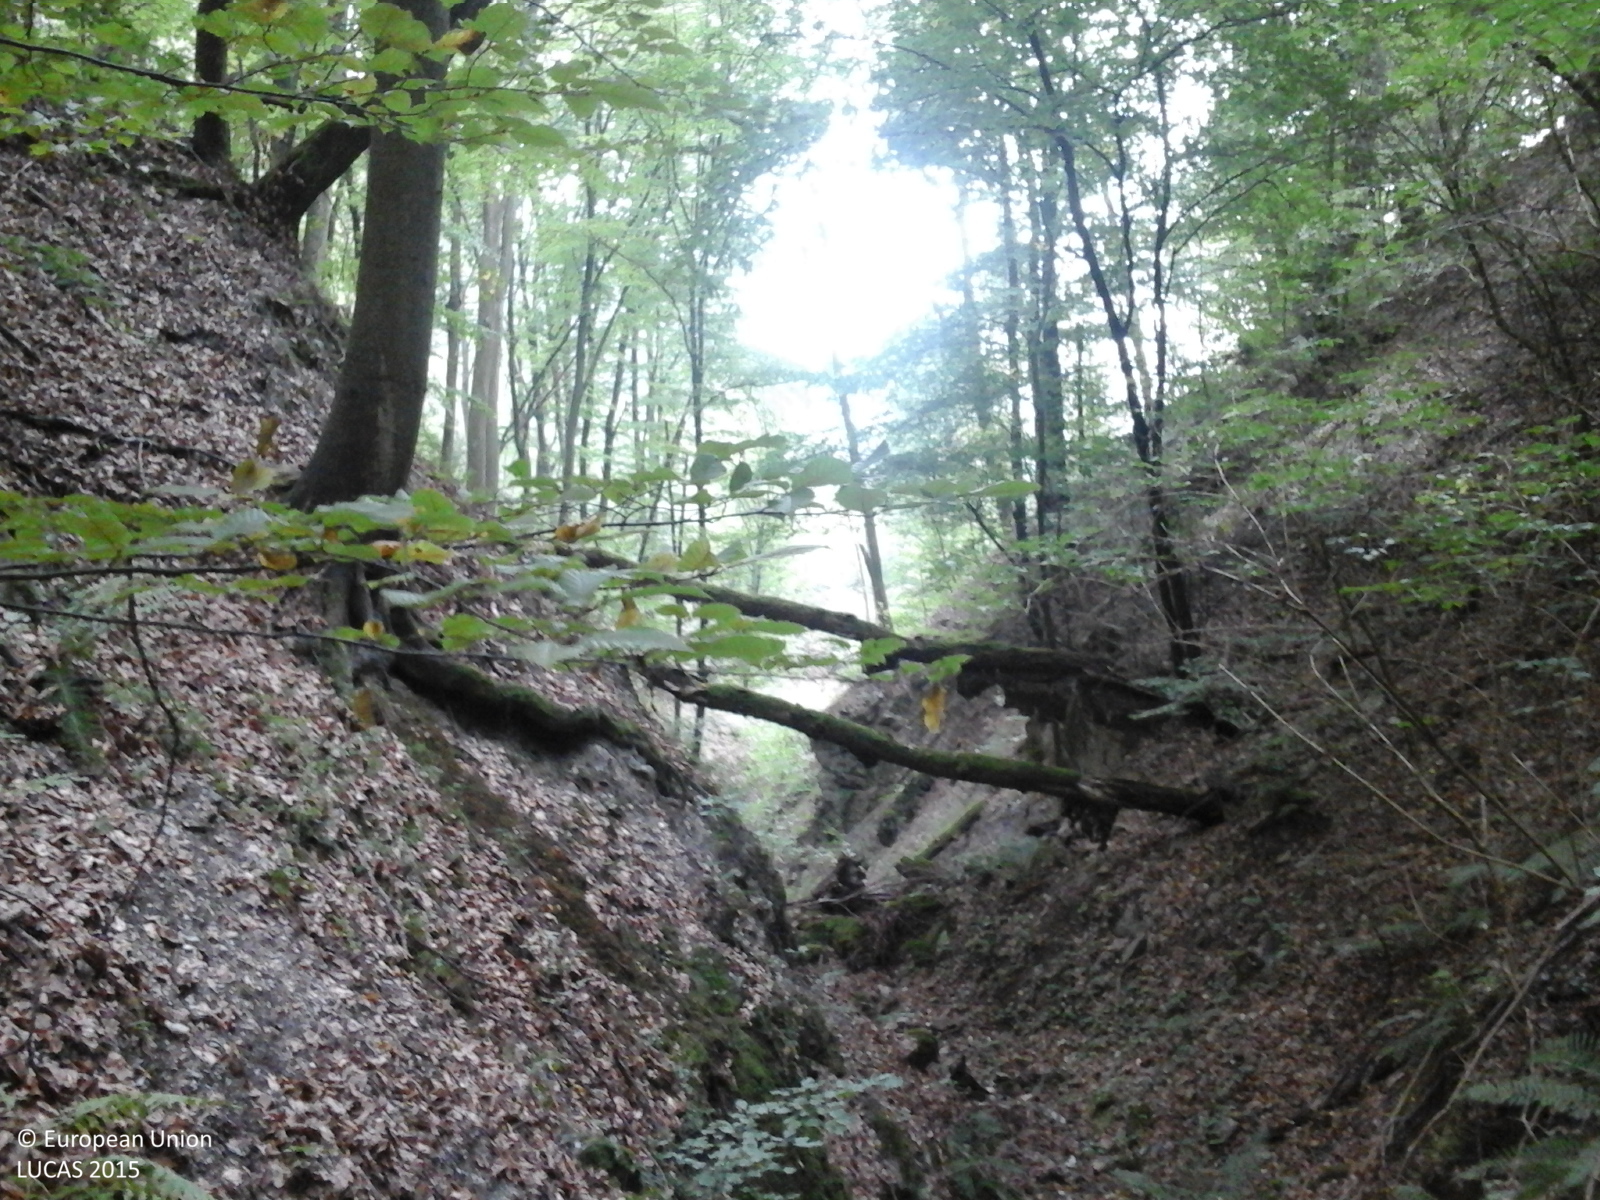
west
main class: Woodland
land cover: Broadleaved woodland
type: mesophytic deciduous forest
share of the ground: > 75 %
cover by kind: broadleaved forest trees 100 %
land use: Forestry
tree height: > 5 m
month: September
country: RO
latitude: 45.9033
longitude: 22.8268
